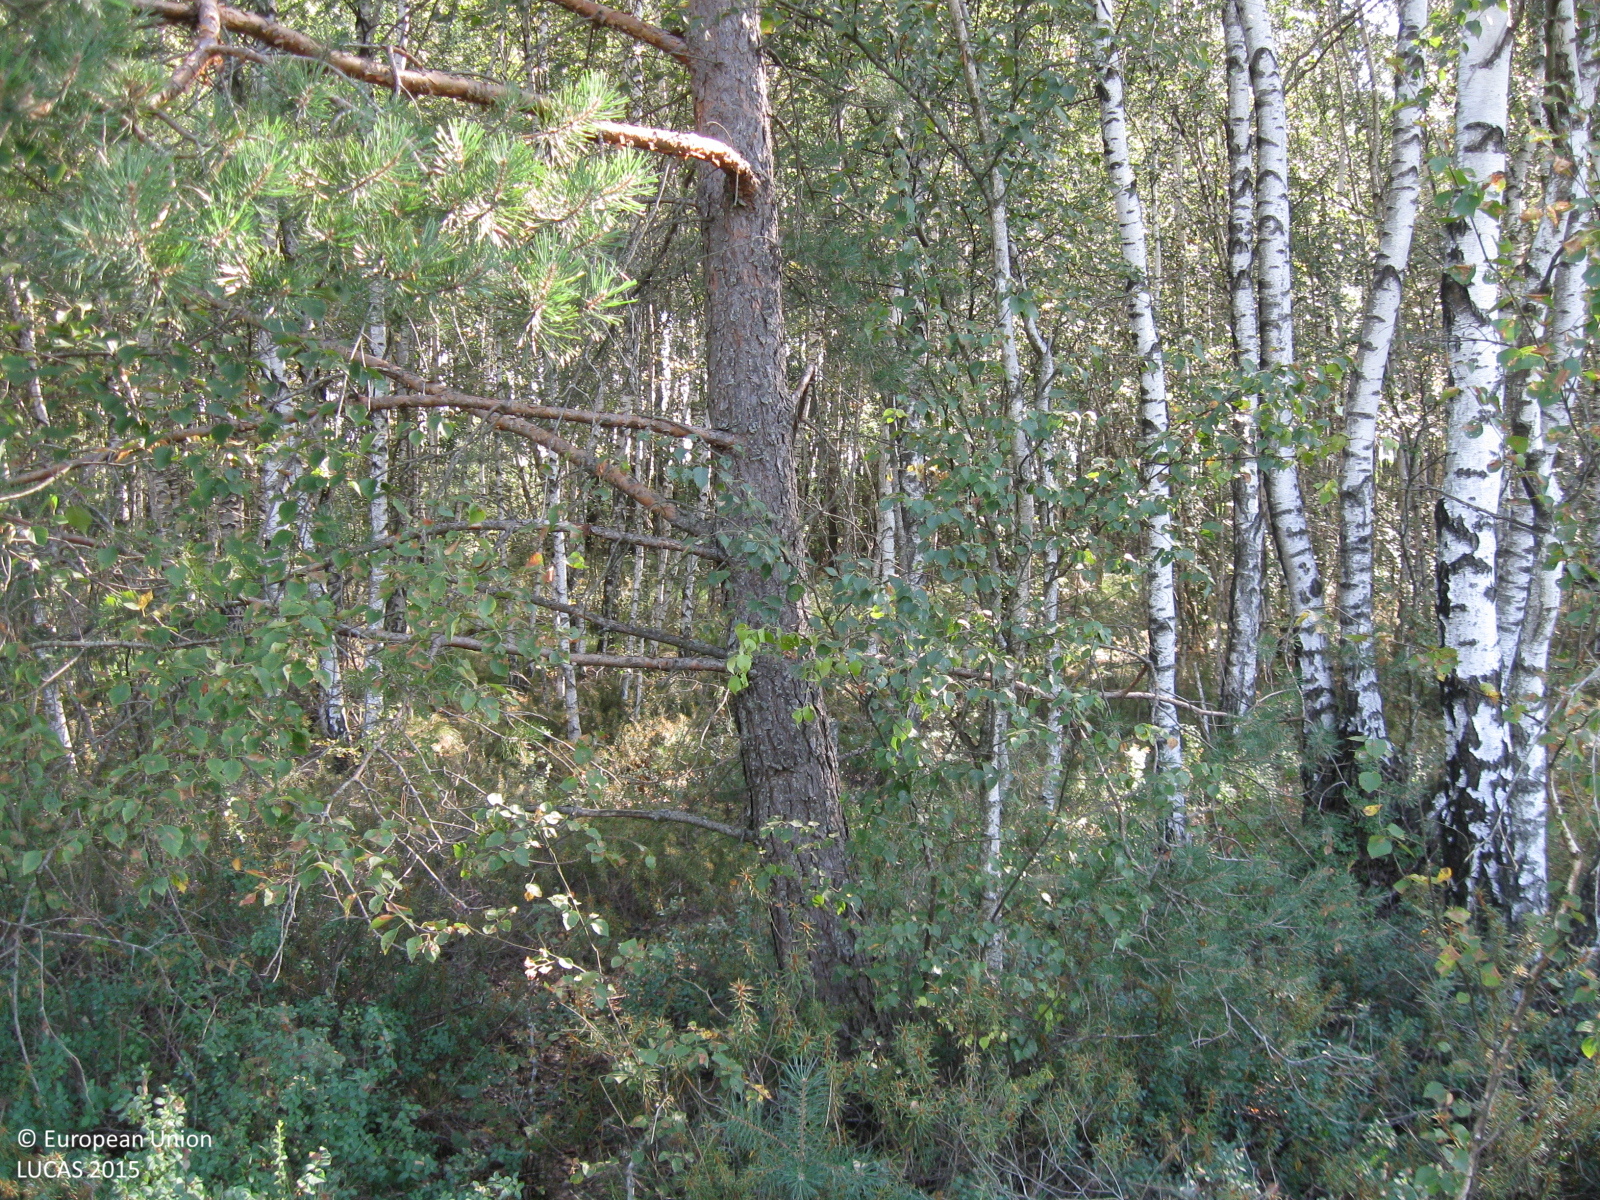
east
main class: Woodland
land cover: Pine dominated mixed woodland
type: mire and swamp forests
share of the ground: 50 - 75 %
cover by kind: broadleaved forest trees 35 %, shrubs 35 %, coniferous forest trees 15 %, herbaceous plants 10 %, lichens and mosses 5 %
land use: Forestry
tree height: > 5 m
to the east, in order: Pine dominated mixed woodland; Broadleaved woodland; Spontaneously vegetated surfaces; Inland fresh running water; Spontaneously vegetated surfaces; Other bare soil
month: August
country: LT
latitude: 55.1288
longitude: 22.7543
